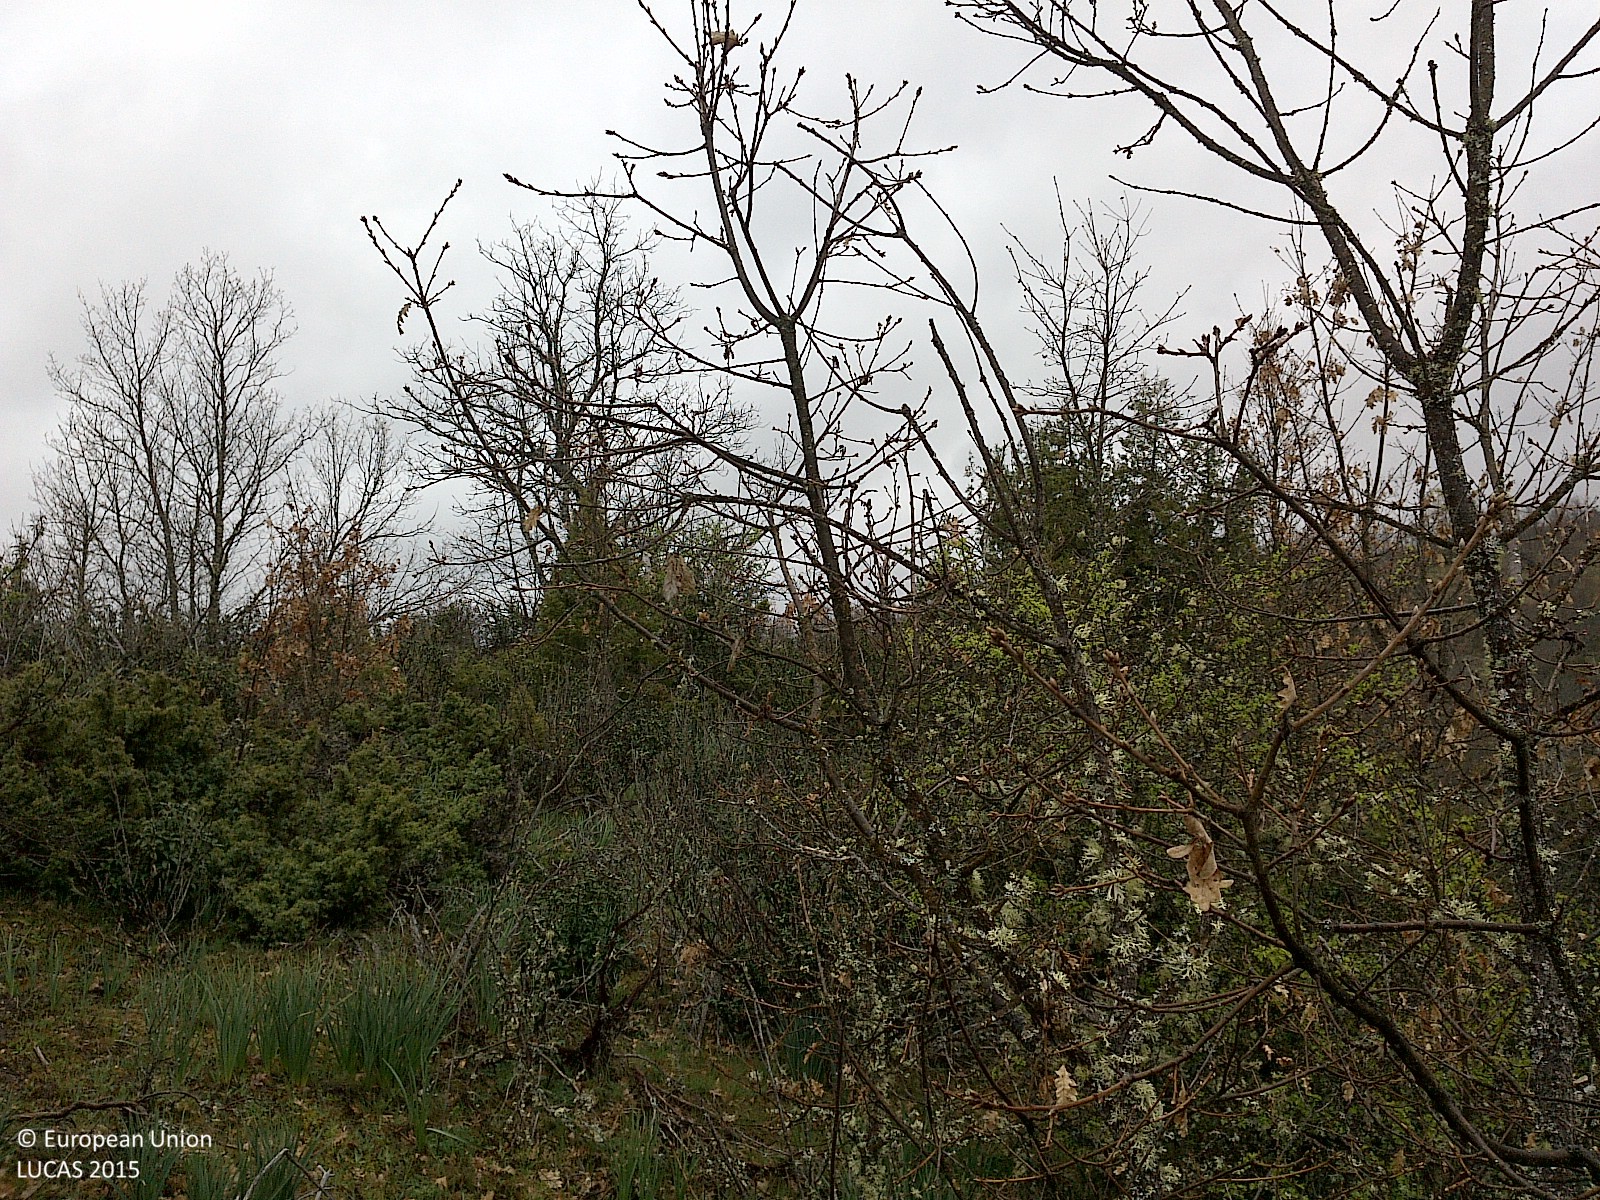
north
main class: Woodland
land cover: Broadleaved woodland
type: thermophilous deciduous forest
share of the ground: 25 - 50 %
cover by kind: shrubs 40 %, broadleaved forest trees 30 %, consolidated bare surface 15 %, herbaceous plants 10 %, coniferous forest trees 5 %
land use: Semi-natural and natural areas not in use
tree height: < 5 m
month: May
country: ES
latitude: 41.9345
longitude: -3.1825
